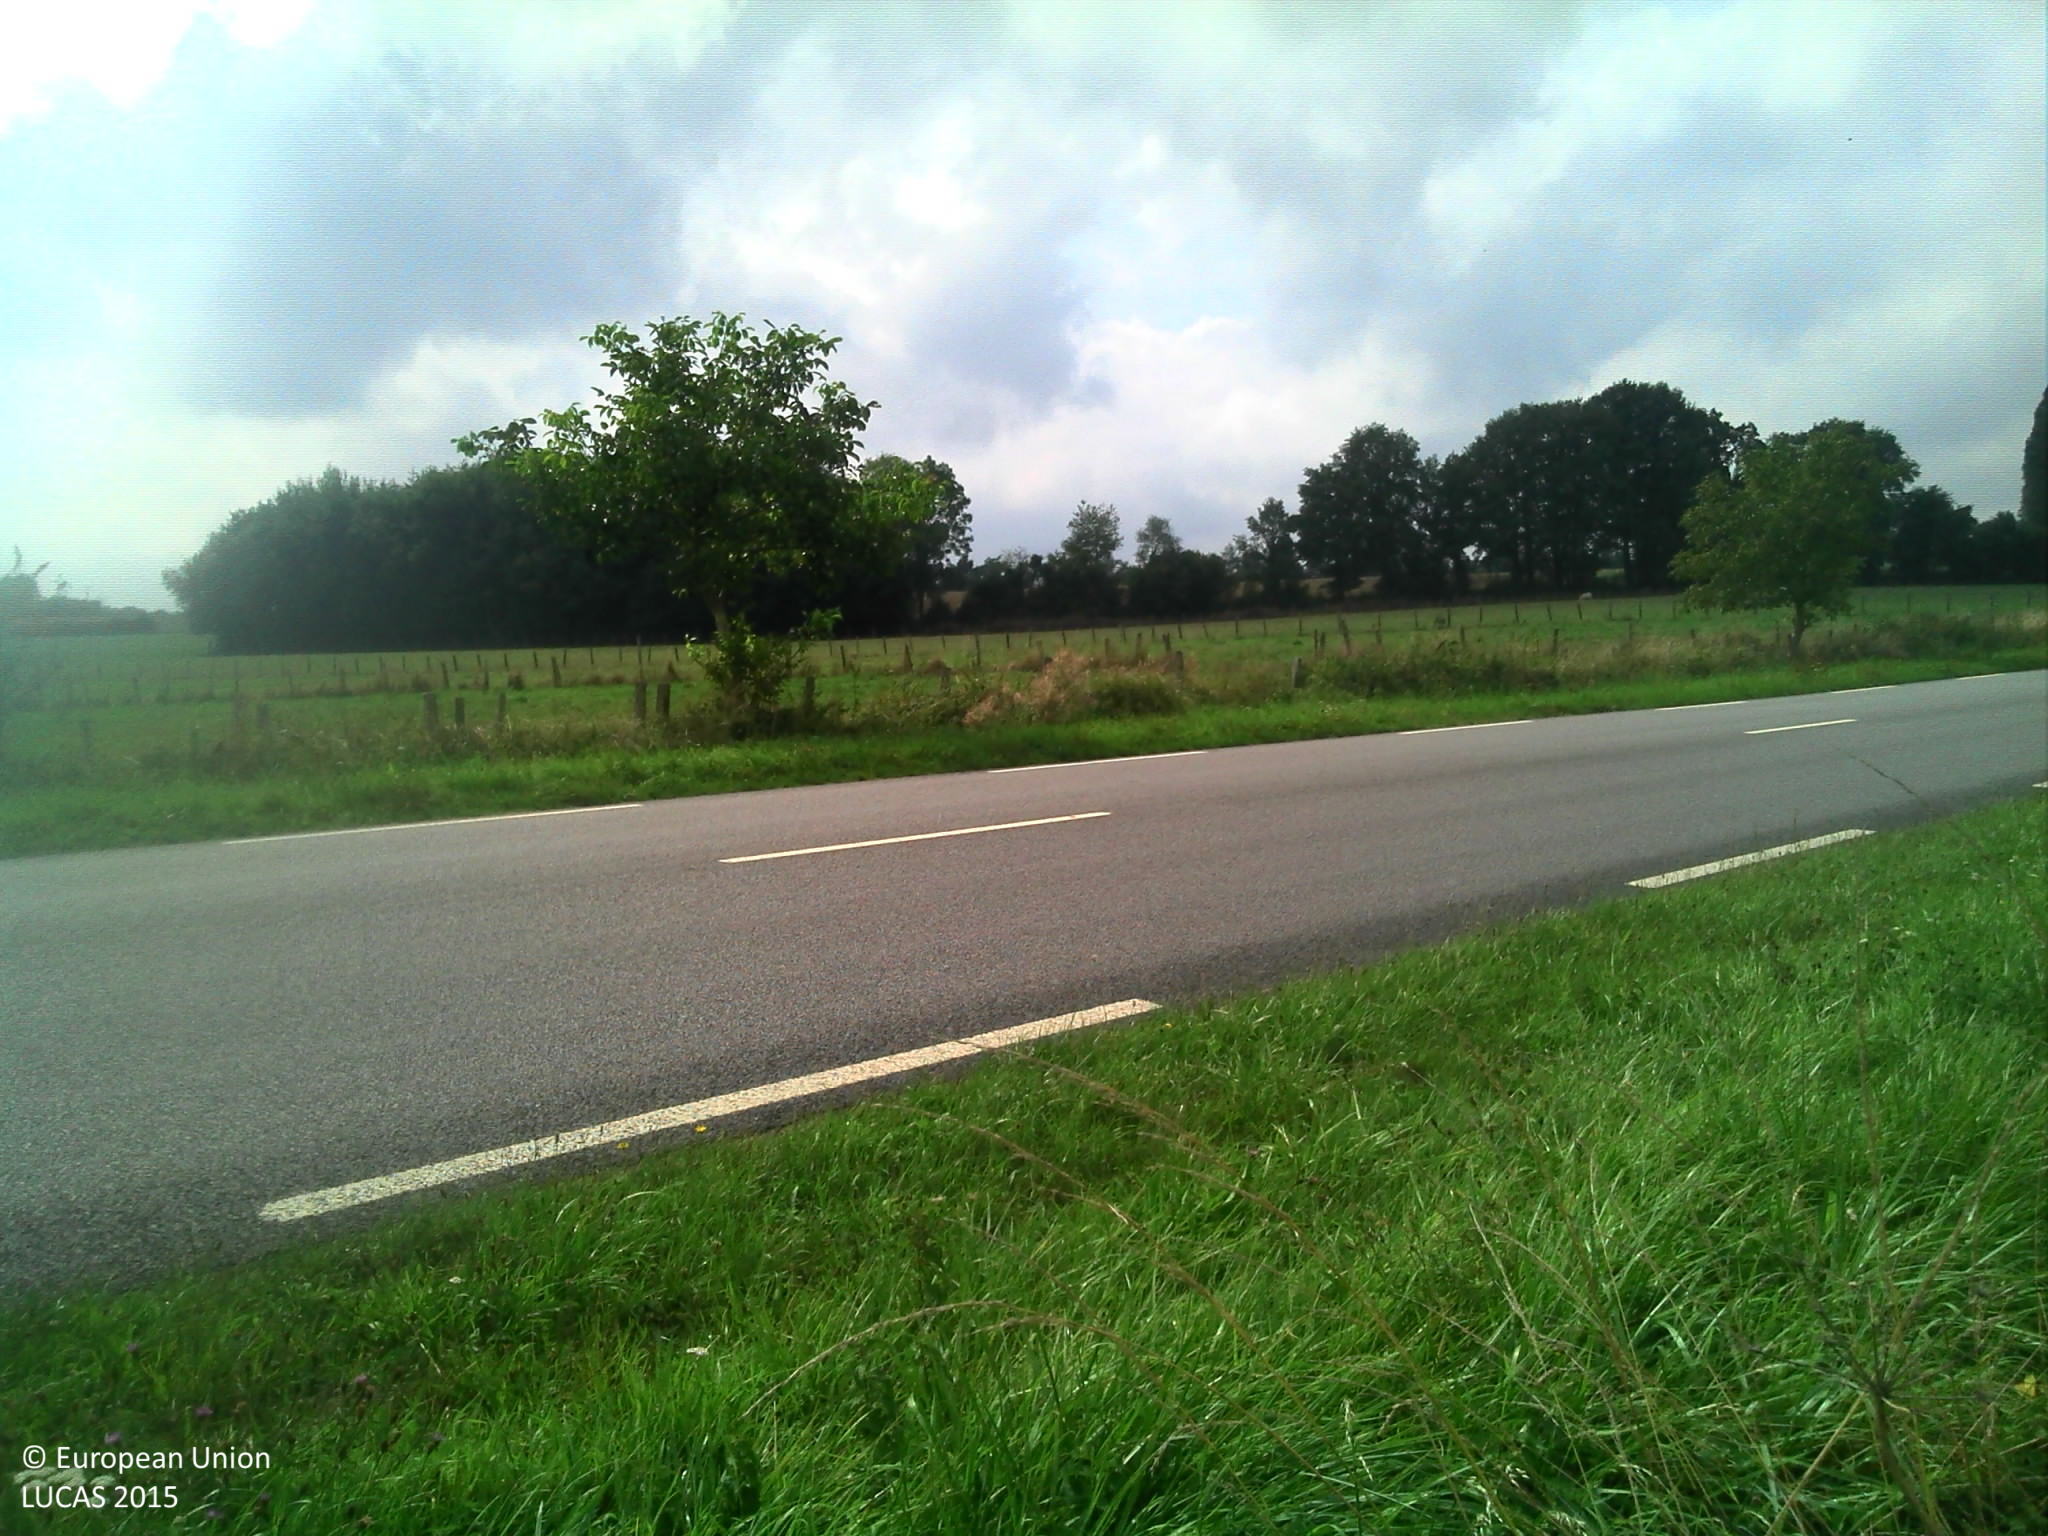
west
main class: Grassland
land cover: Grassland without tree/shrub cover
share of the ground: > 75 %
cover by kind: herbaceous plants 100 %
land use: Agriculture (excluding fallow land and kitchen gardens)
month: August
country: FR
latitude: 48.5067
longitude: 0.5686
